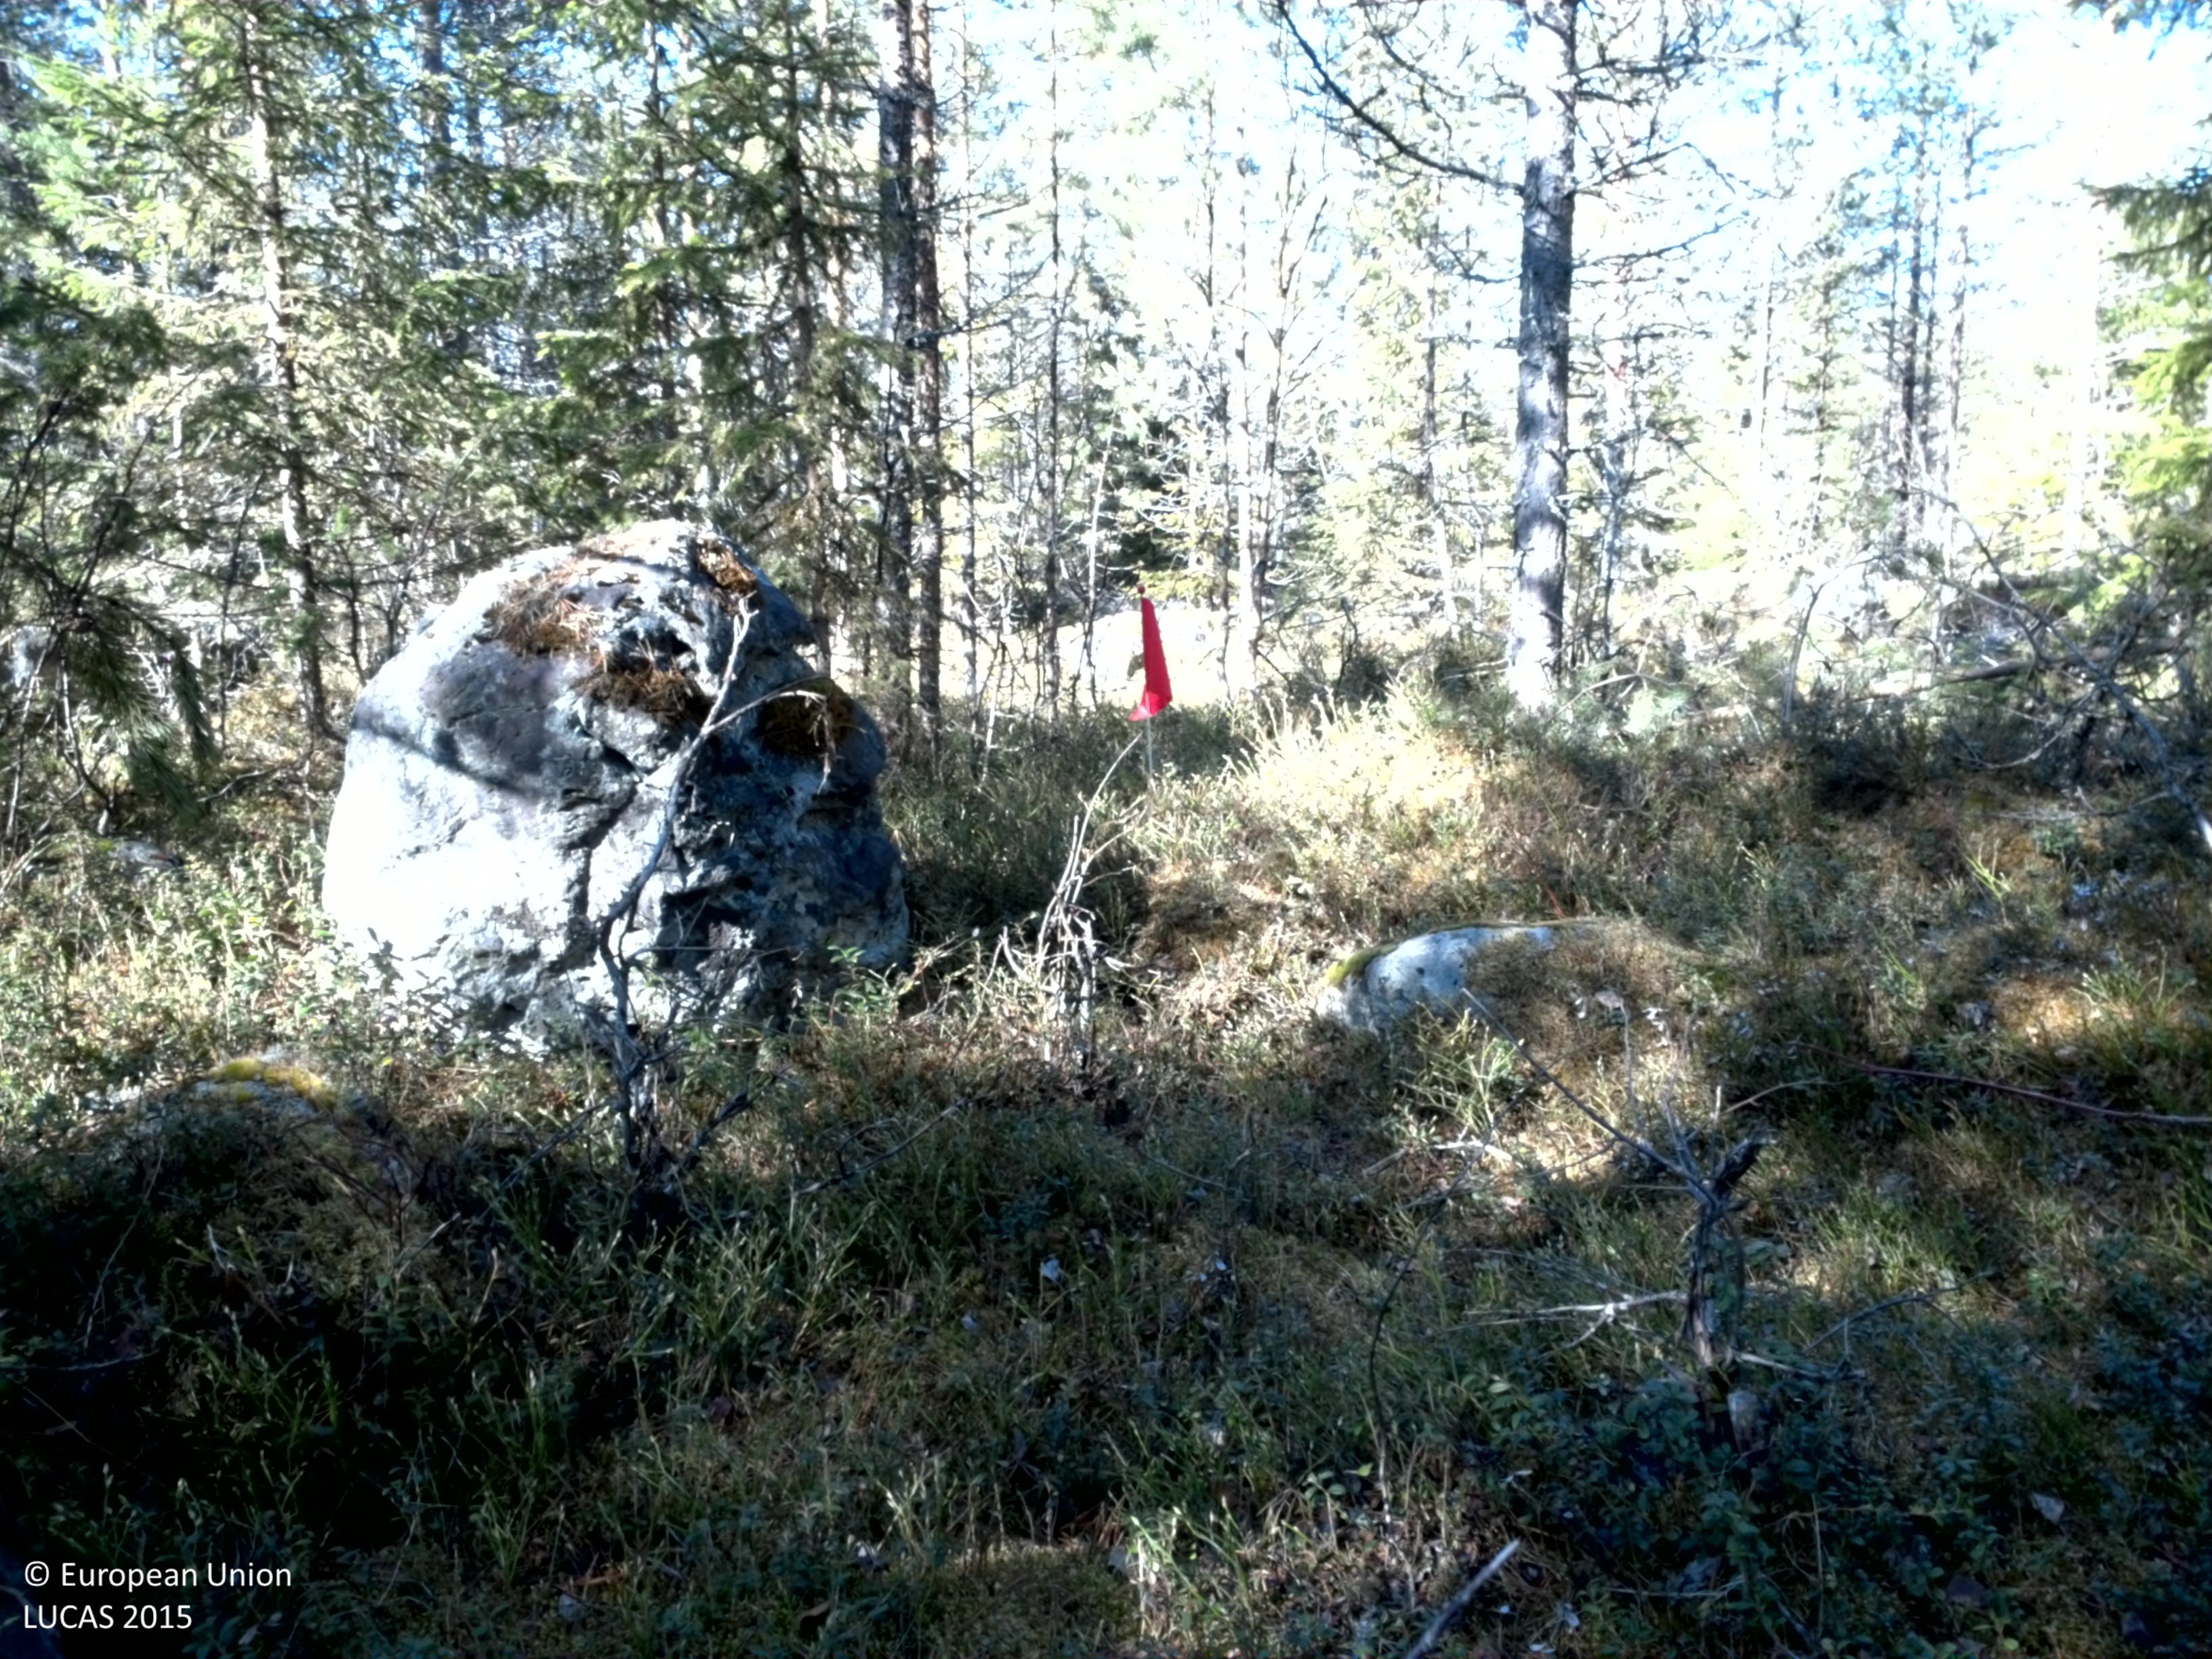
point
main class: Woodland
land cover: Pine dominated coniferous woodland
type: boreal forest
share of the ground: > 75 %
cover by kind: coniferous forest trees 80 %, shrubs 20 %
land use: Forestry
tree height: > 5 m
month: May
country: SE
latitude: 65.9081
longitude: 24.0292
